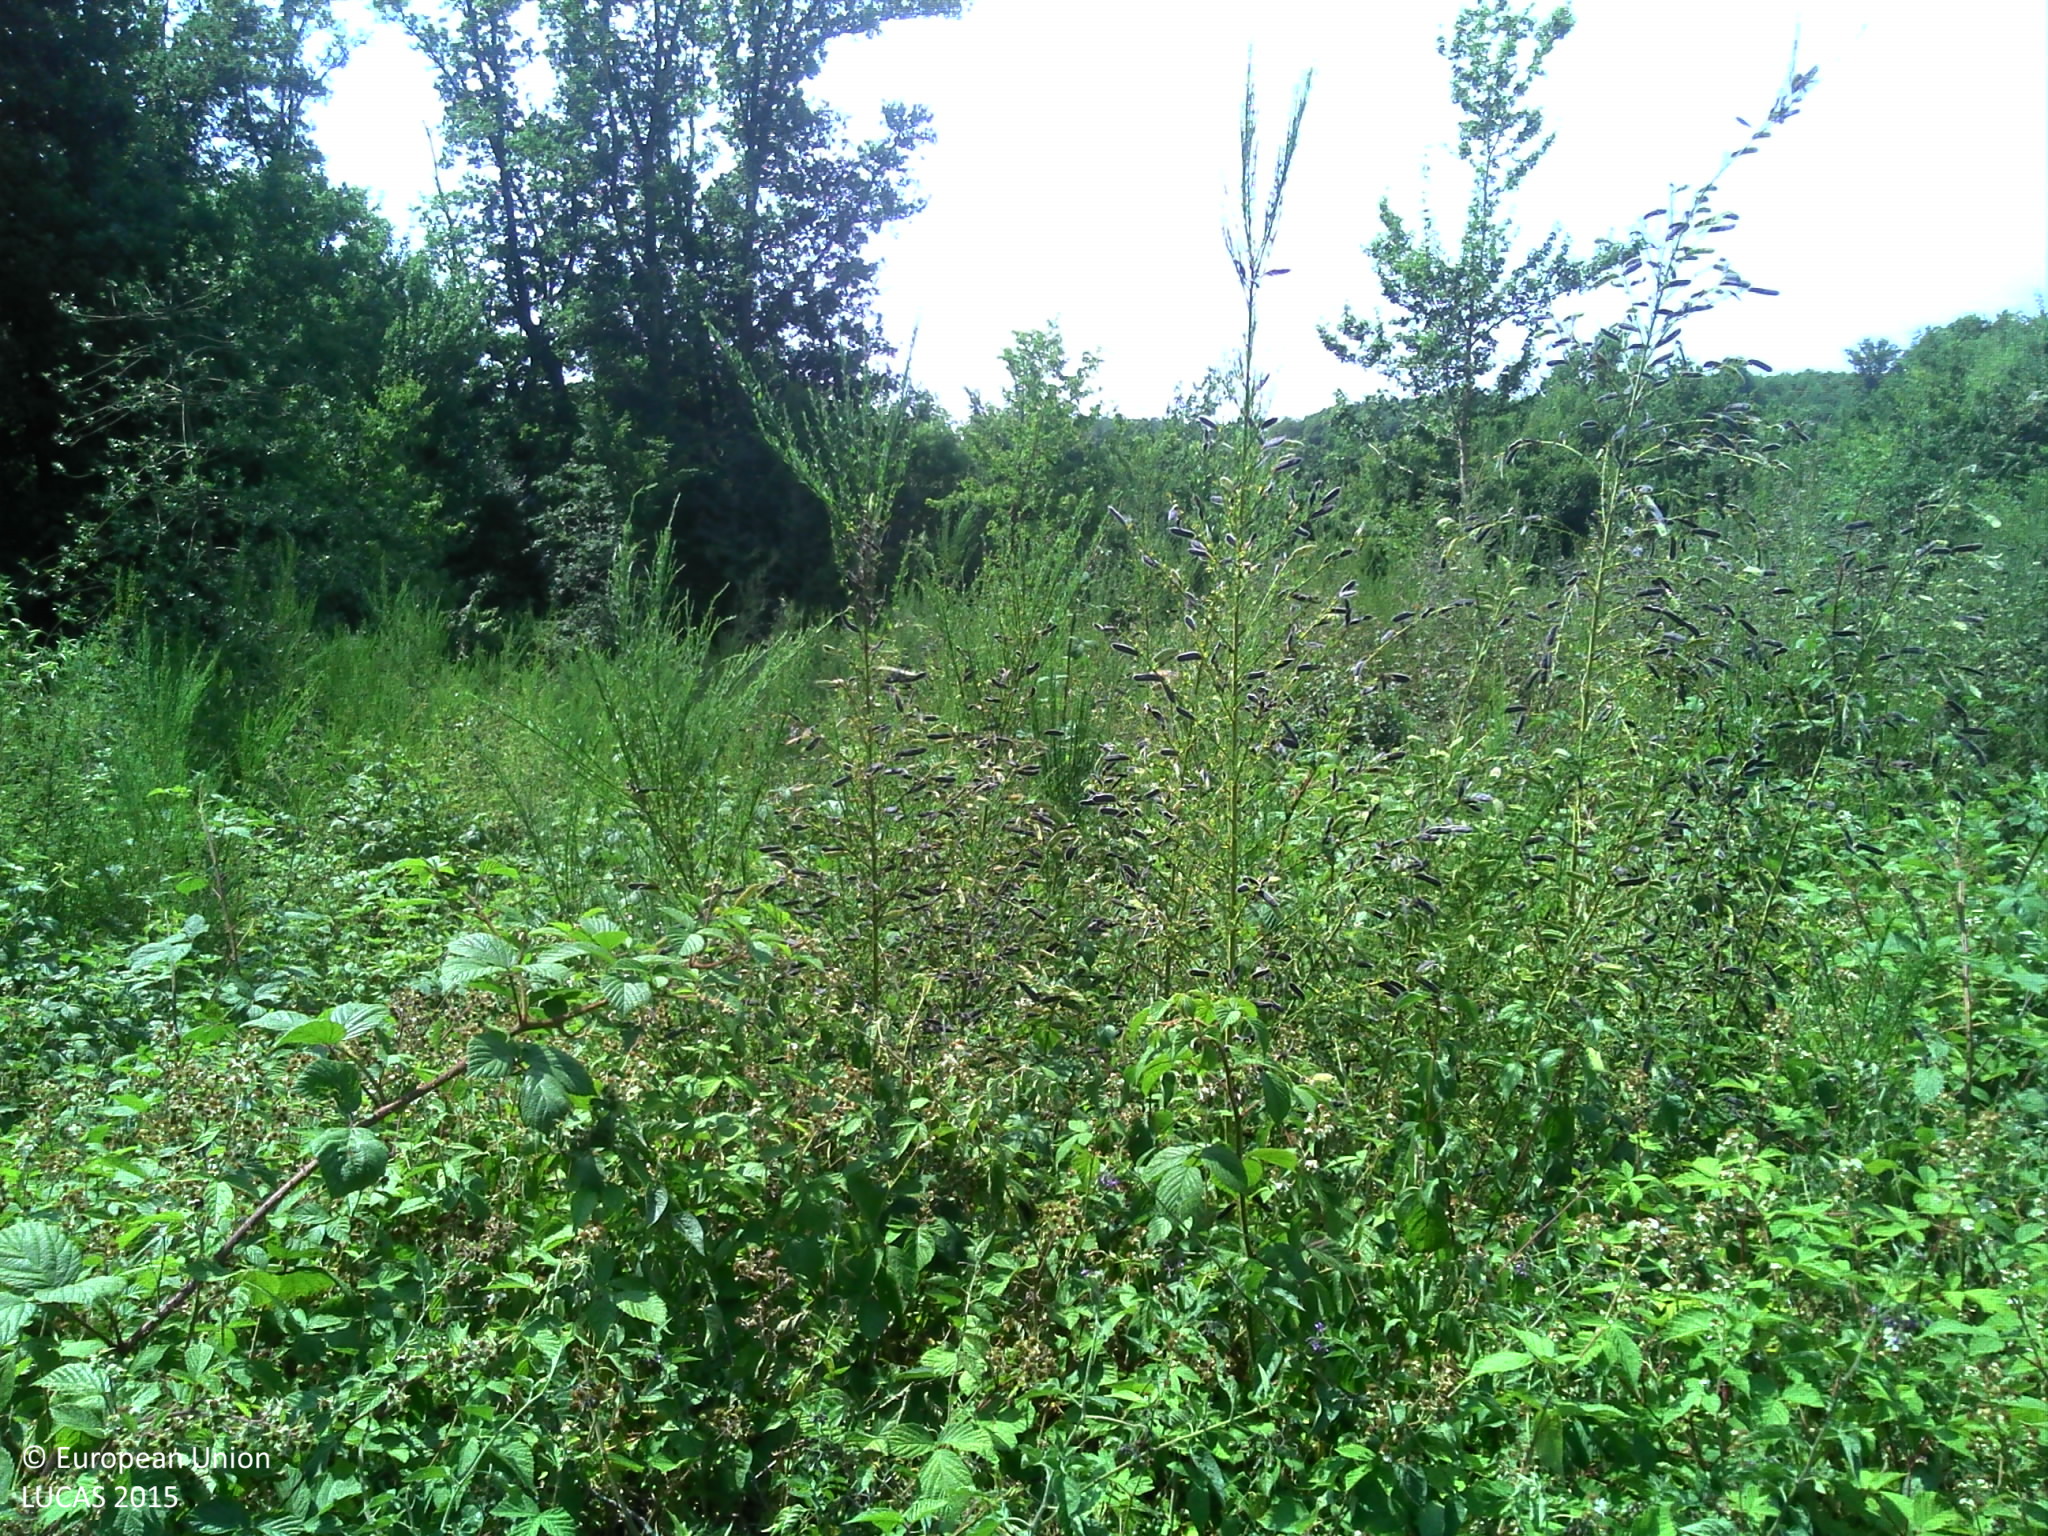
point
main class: Shrubland
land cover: Shrubland without tree cover
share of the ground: > 75 %
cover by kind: herbaceous plants 60 %, shrubs 40 %
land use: Forestry
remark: Clear cut
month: July
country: FR
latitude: 48.8119
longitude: 1.1970
